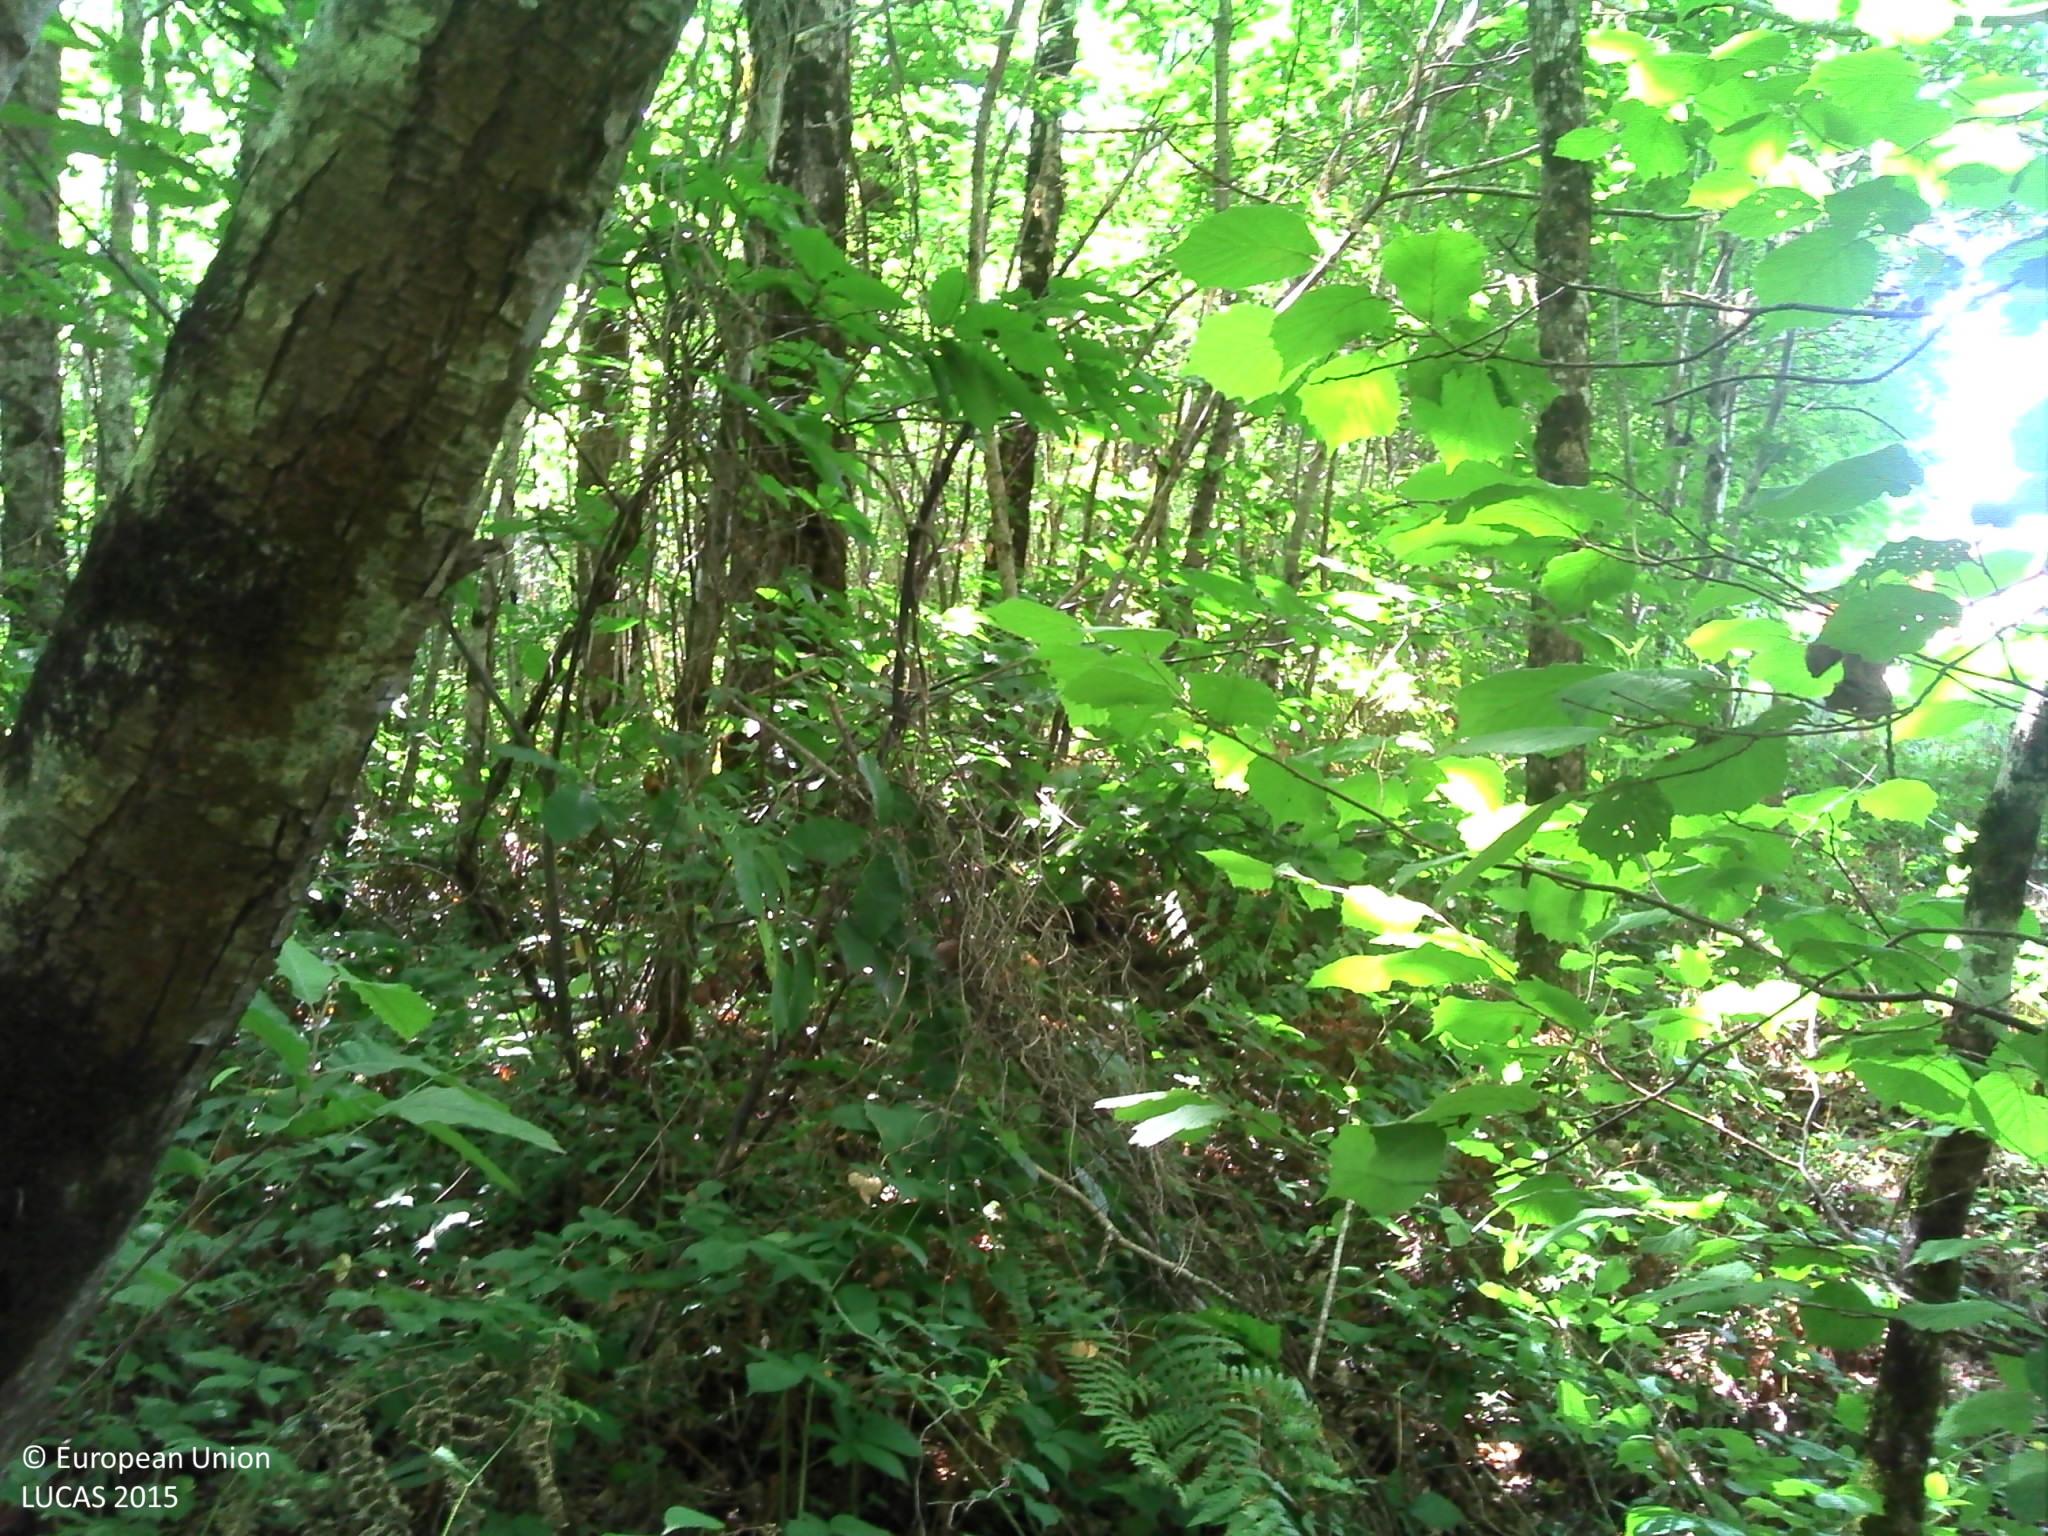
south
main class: Woodland
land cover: Broadleaved woodland
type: mesophytic deciduous forest
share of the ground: > 75 %
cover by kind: broadleaved forest trees 70 %, shrubs 10 %, herbaceous plants 10 %, consolidated bare surface 10 %
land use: Forestry
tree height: > 5 m
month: August
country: FR
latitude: 45.2229
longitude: 0.7315
